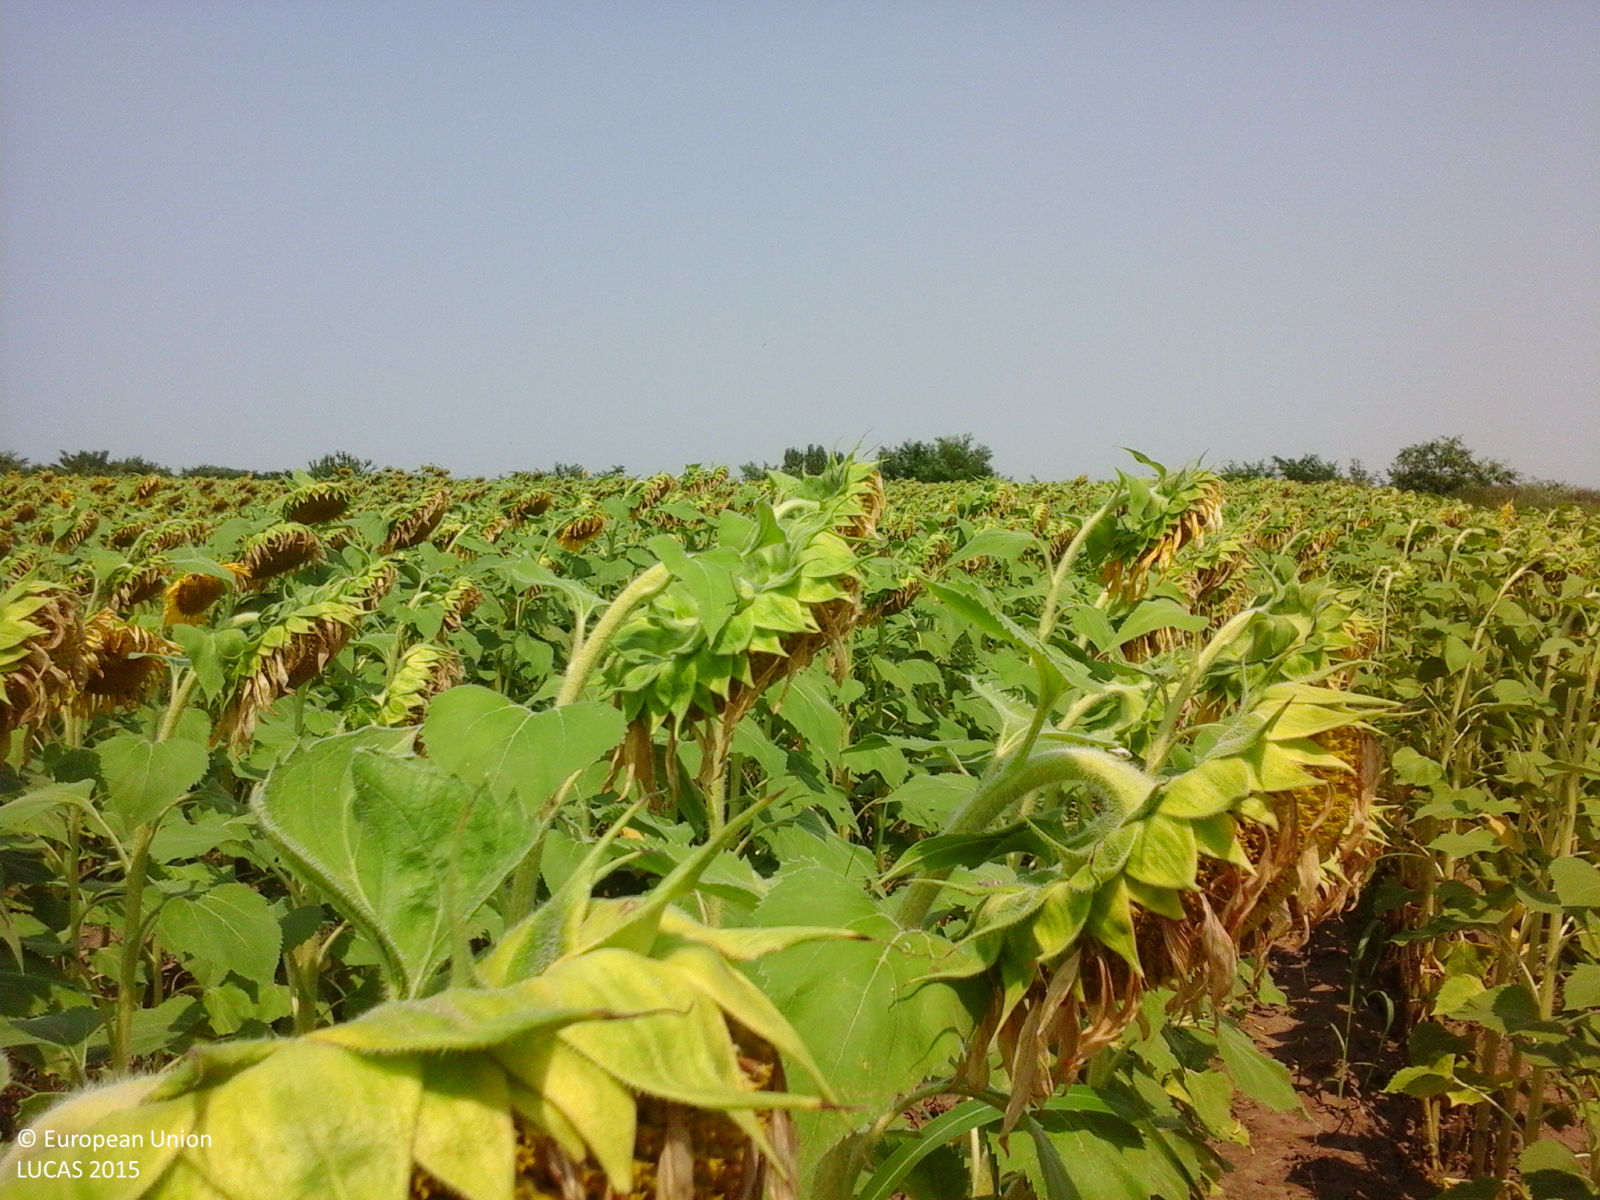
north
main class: Cropland
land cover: Sunflower
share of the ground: > 75 %
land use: Agriculture (excluding fallow land and kitchen gardens)
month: July
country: RO
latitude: 44.6602
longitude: 26.5774
